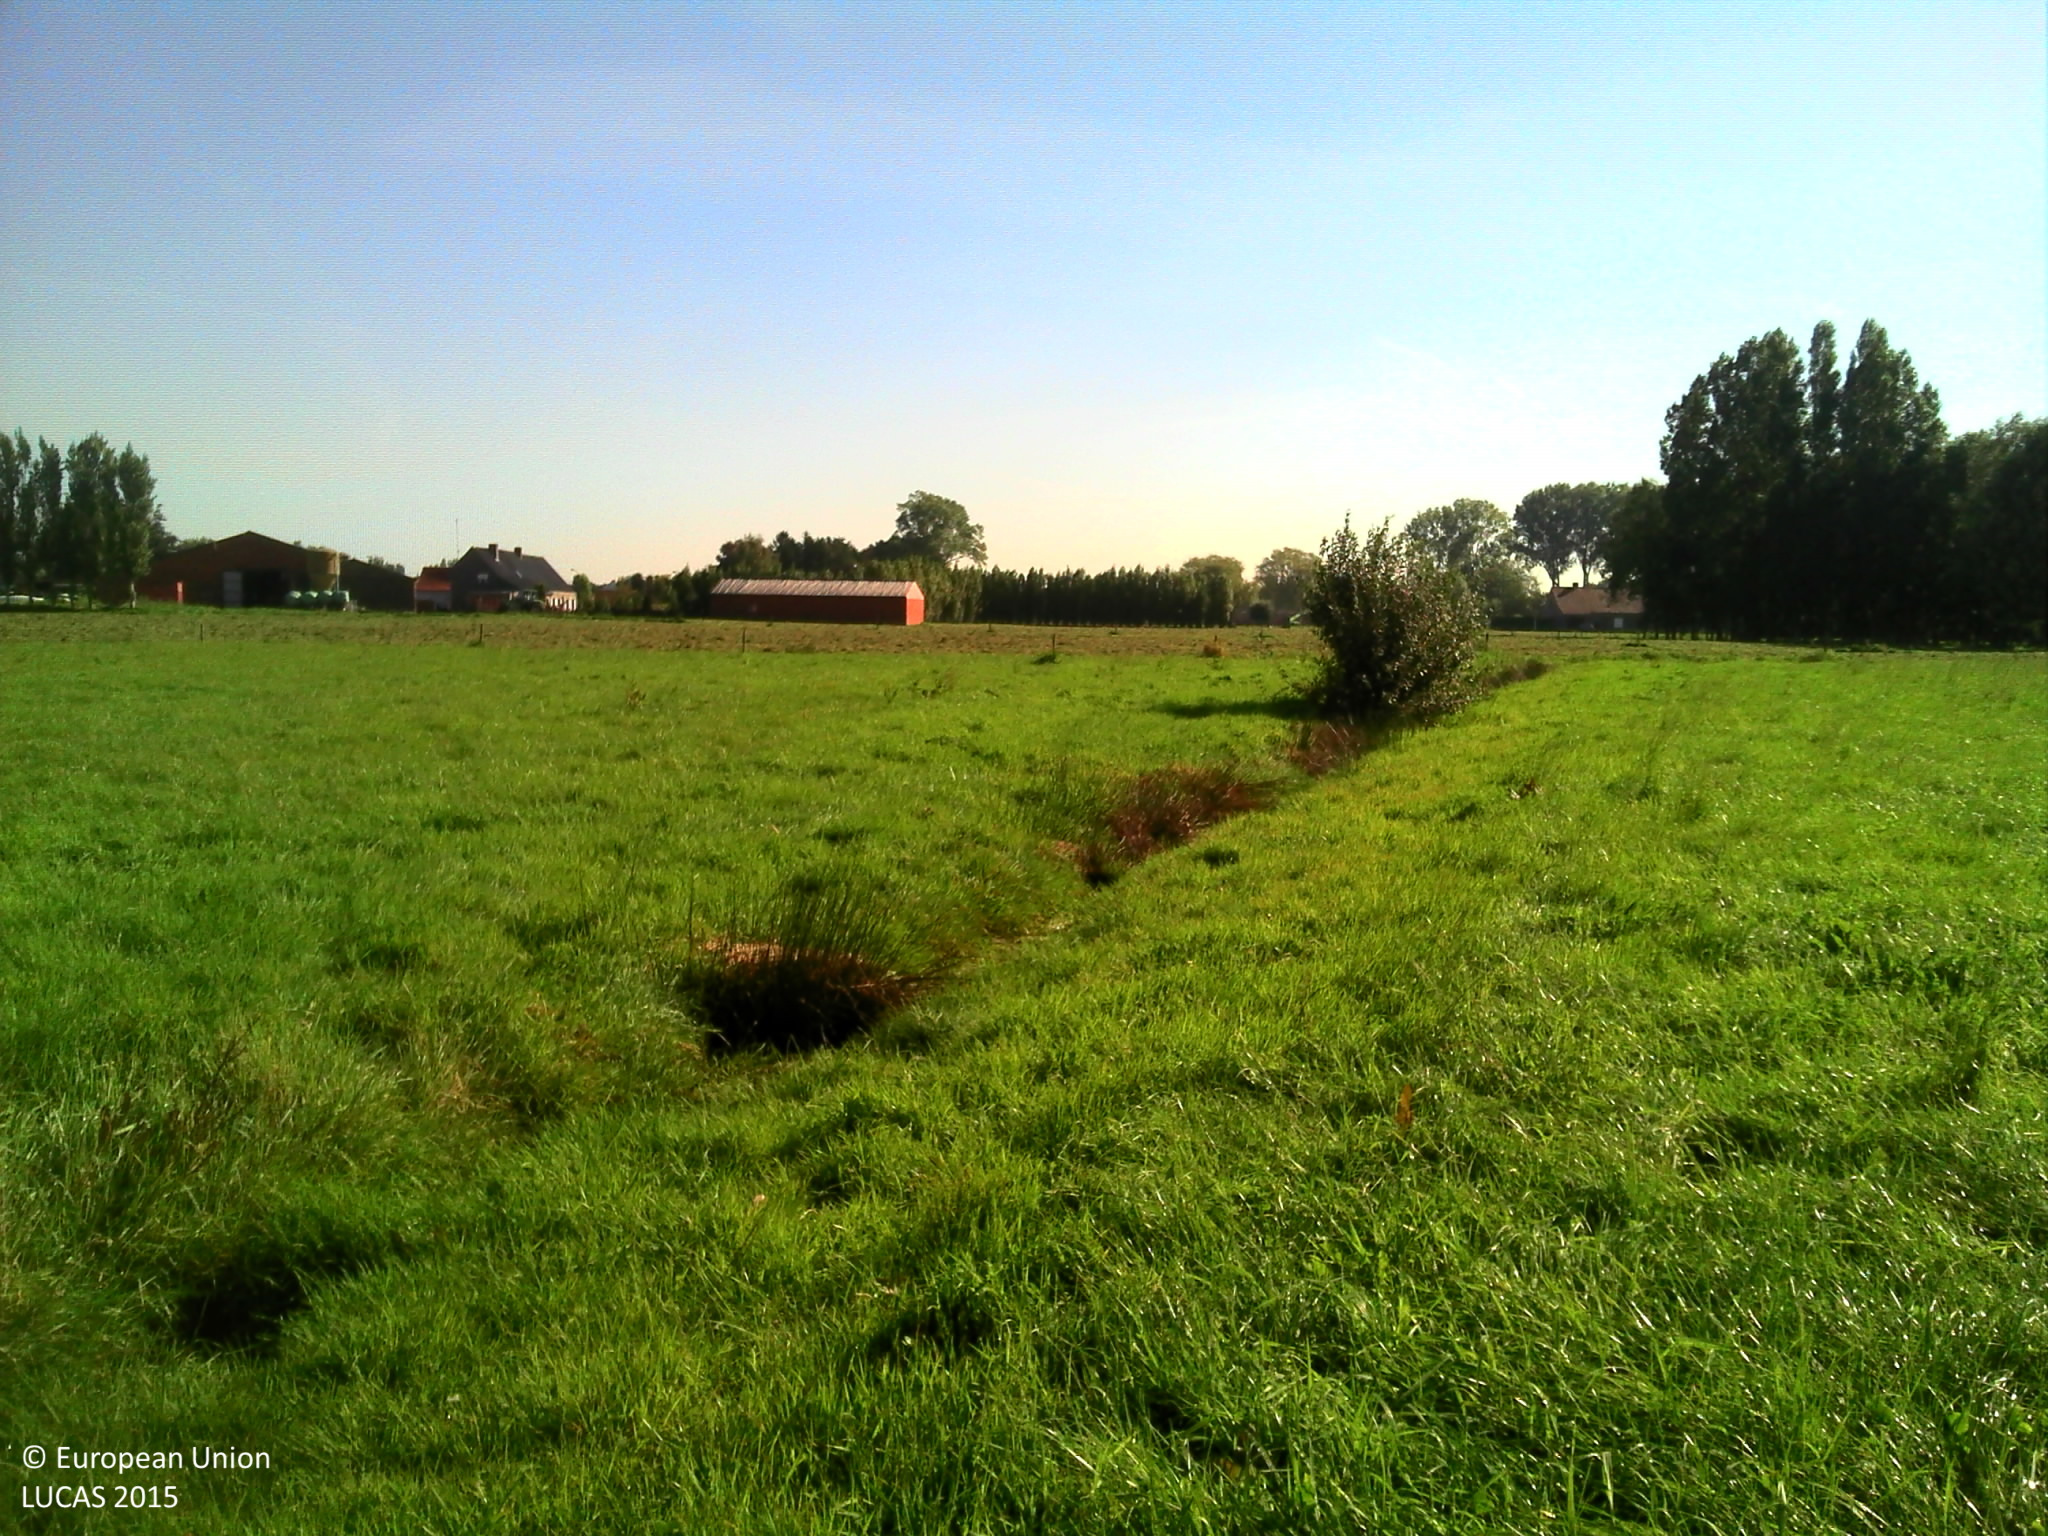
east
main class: Grassland
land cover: Grassland without tree/shrub cover
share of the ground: > 75 %
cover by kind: herbaceous plants 100 %
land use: Agriculture (excluding fallow land and kitchen gardens)
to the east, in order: Grassland without tree/shrub cover; Ditches and canals; Grassland without tree/shrub cover; Ditches and canals; Fences; Grassland without tree/shrub cover; Fences; Grassland without tree/shrub cover; Fences; Lines of trees; Tracks; Lines of trees; Fences; Grassland without tree/shrub cover
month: September
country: BE
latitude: 51.1477
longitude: 3.4016
